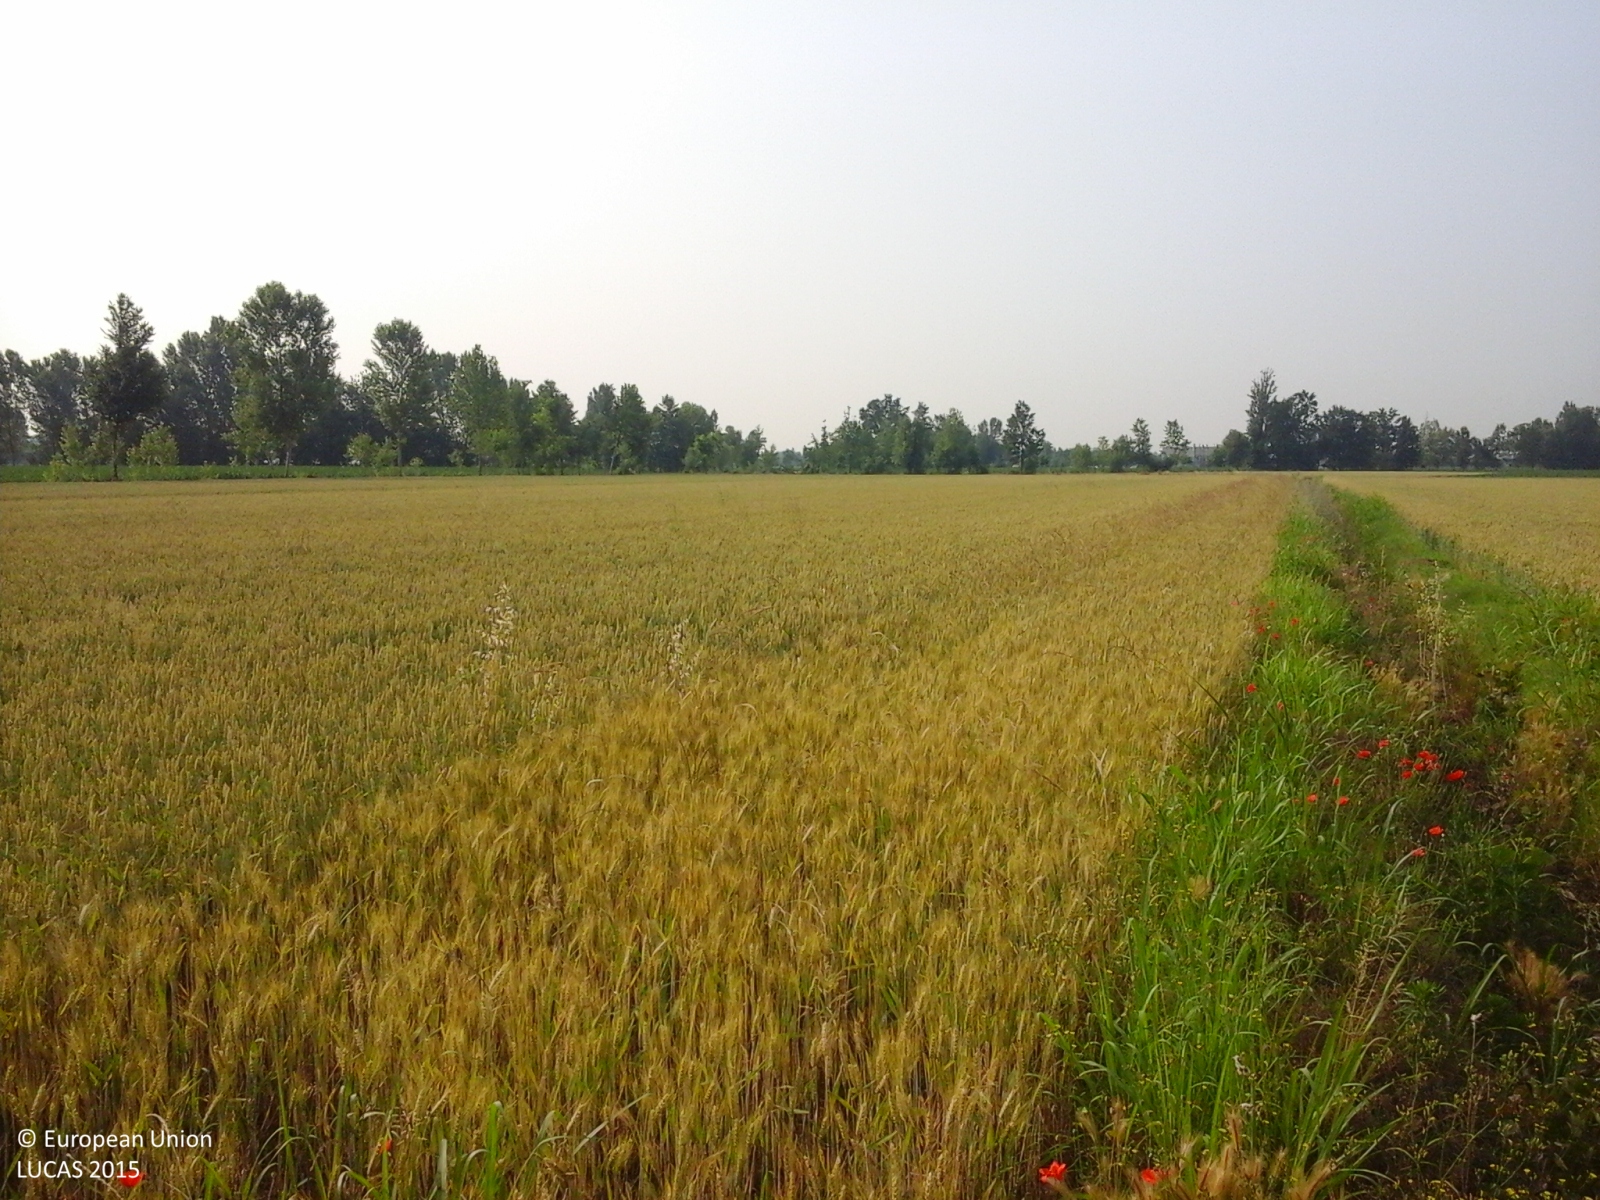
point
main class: Cropland
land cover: Common wheat
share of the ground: > 75 %
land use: Agriculture (excluding fallow land and kitchen gardens)
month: June
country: IT
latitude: 45.4503
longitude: 10.0638
